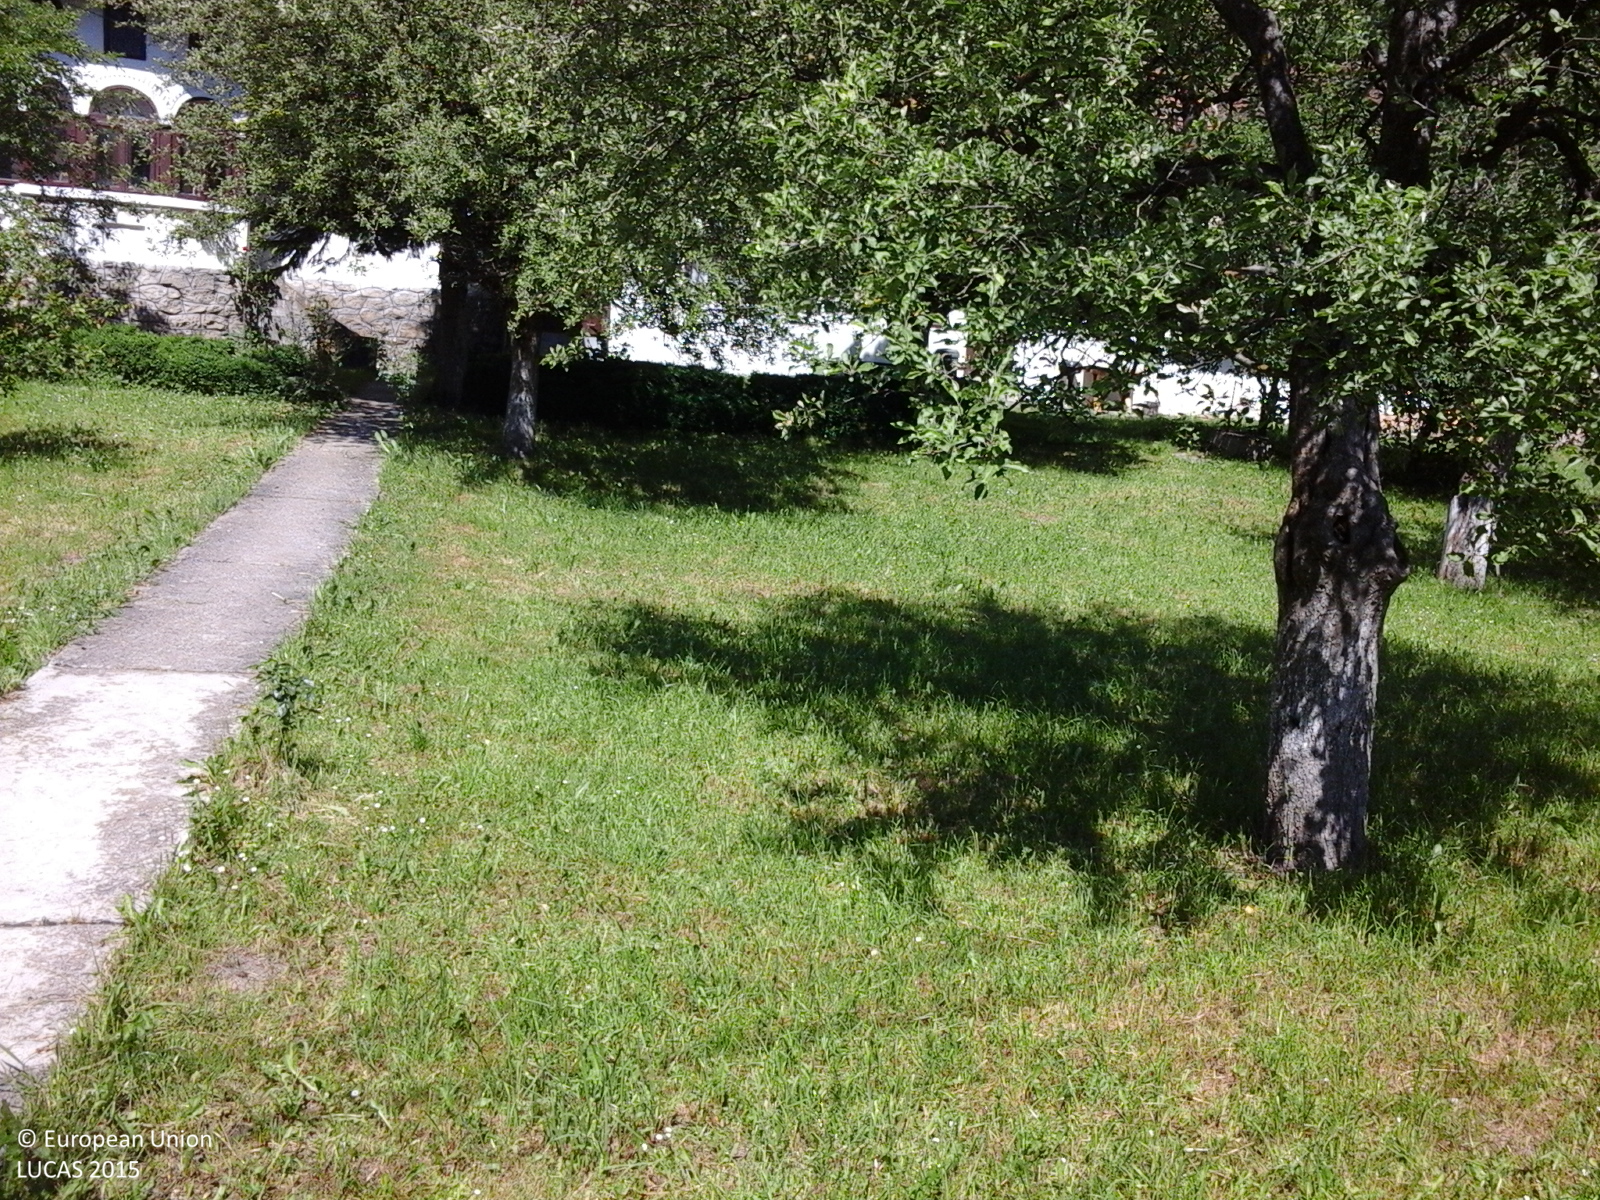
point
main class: Cropland
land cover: Apple fruit
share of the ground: 25 - 50 %
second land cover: Grassland without tree/shrub cover
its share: 50 - 75 %
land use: Agriculture (excluding fallow land and kitchen gardens)
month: June
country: RO
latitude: 45.3885
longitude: 25.1770
